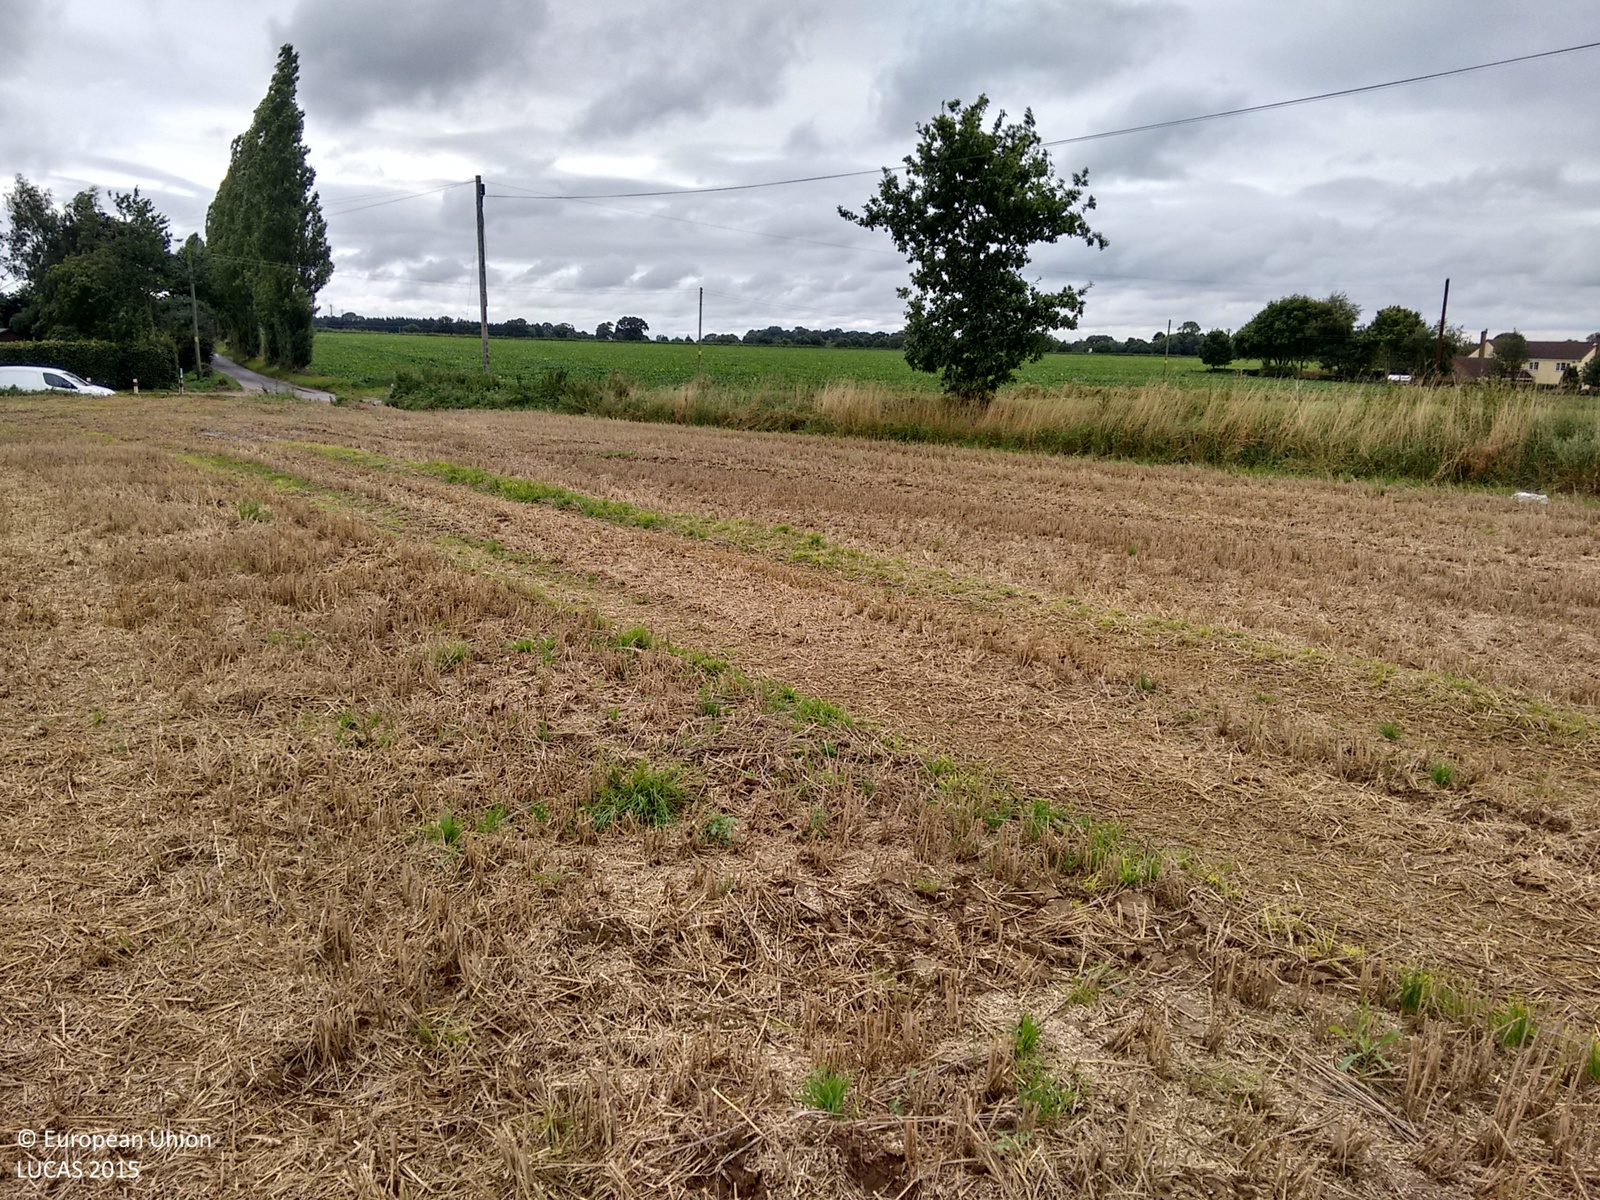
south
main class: Cropland
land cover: Common wheat
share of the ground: > 75 %
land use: Agriculture (excluding fallow land and kitchen gardens)
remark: Harvested field
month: September
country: GB
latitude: 52.6474
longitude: 1.4524
